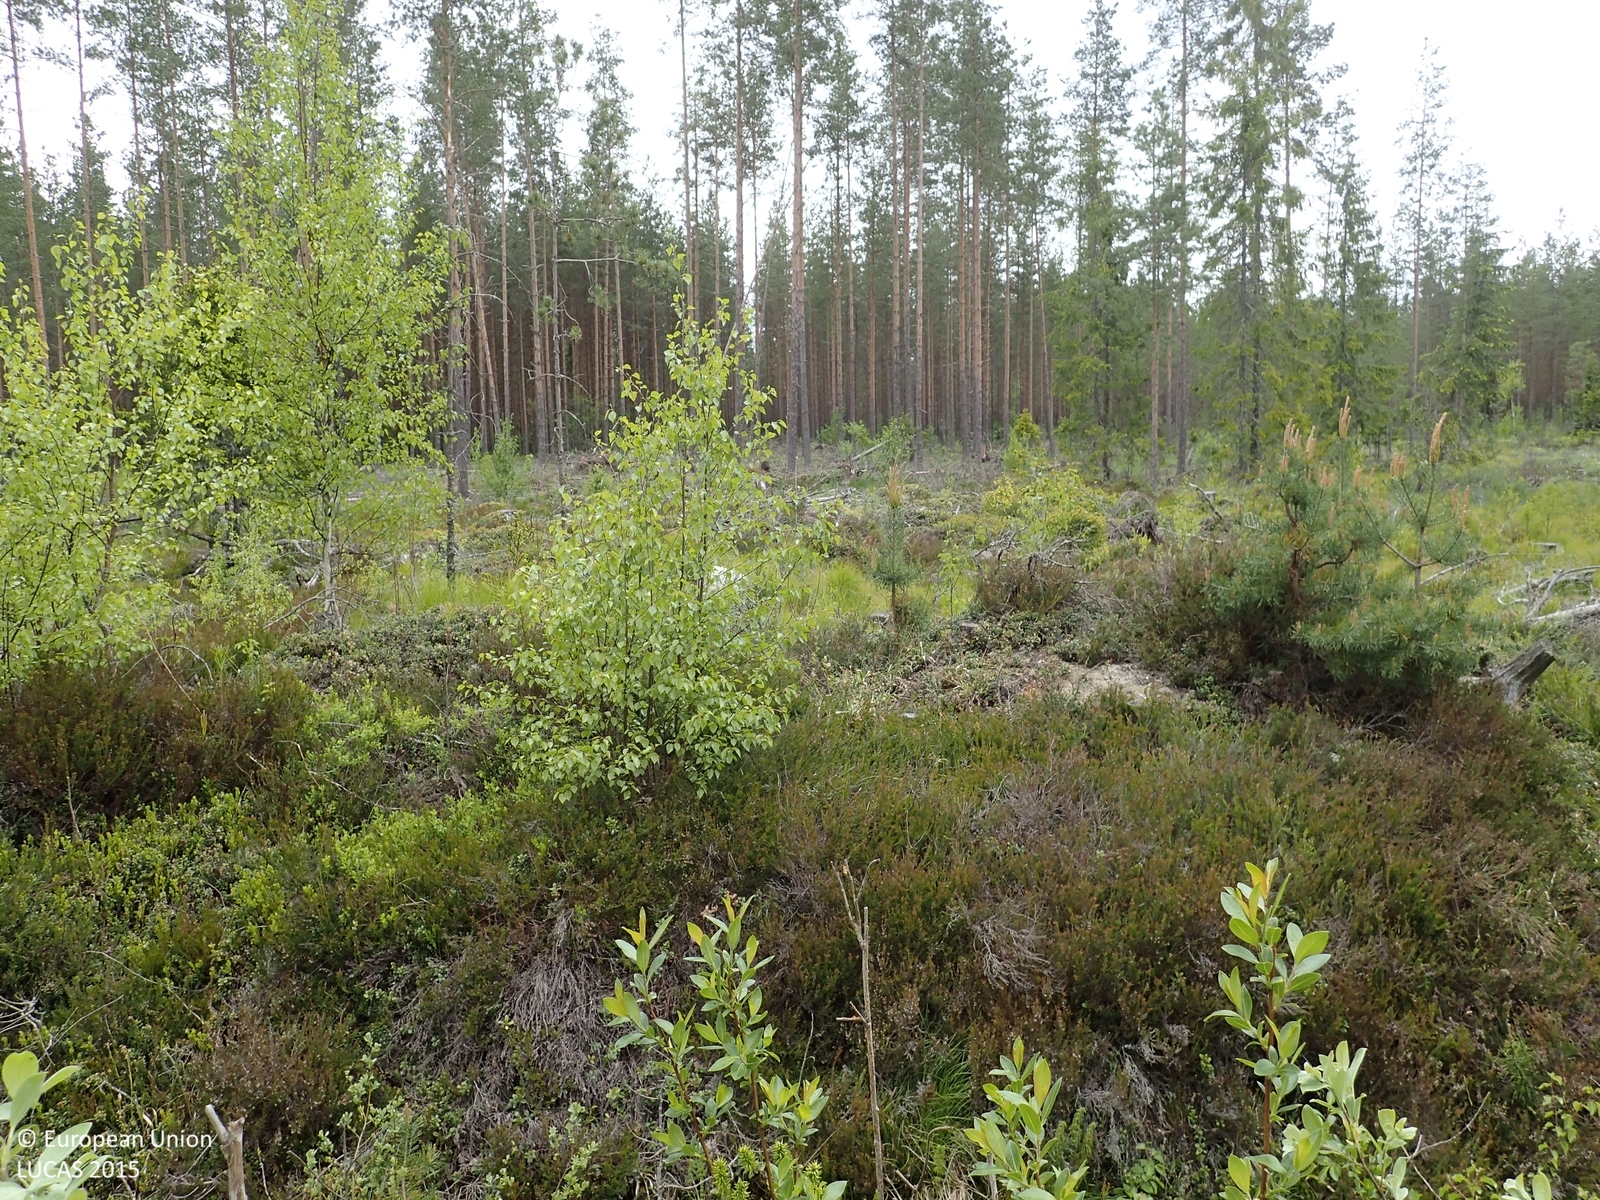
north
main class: Woodland
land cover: Pine dominated coniferous woodland
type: boreal forest
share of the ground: 25 - 50 %
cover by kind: herbaceous plants 40 %, shrubs 35 %, coniferous forest trees 20 %, broadleaved forest trees 5 %
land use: Forestry
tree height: > 5 m
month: June
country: FI
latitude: 62.2789
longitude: 21.7447
